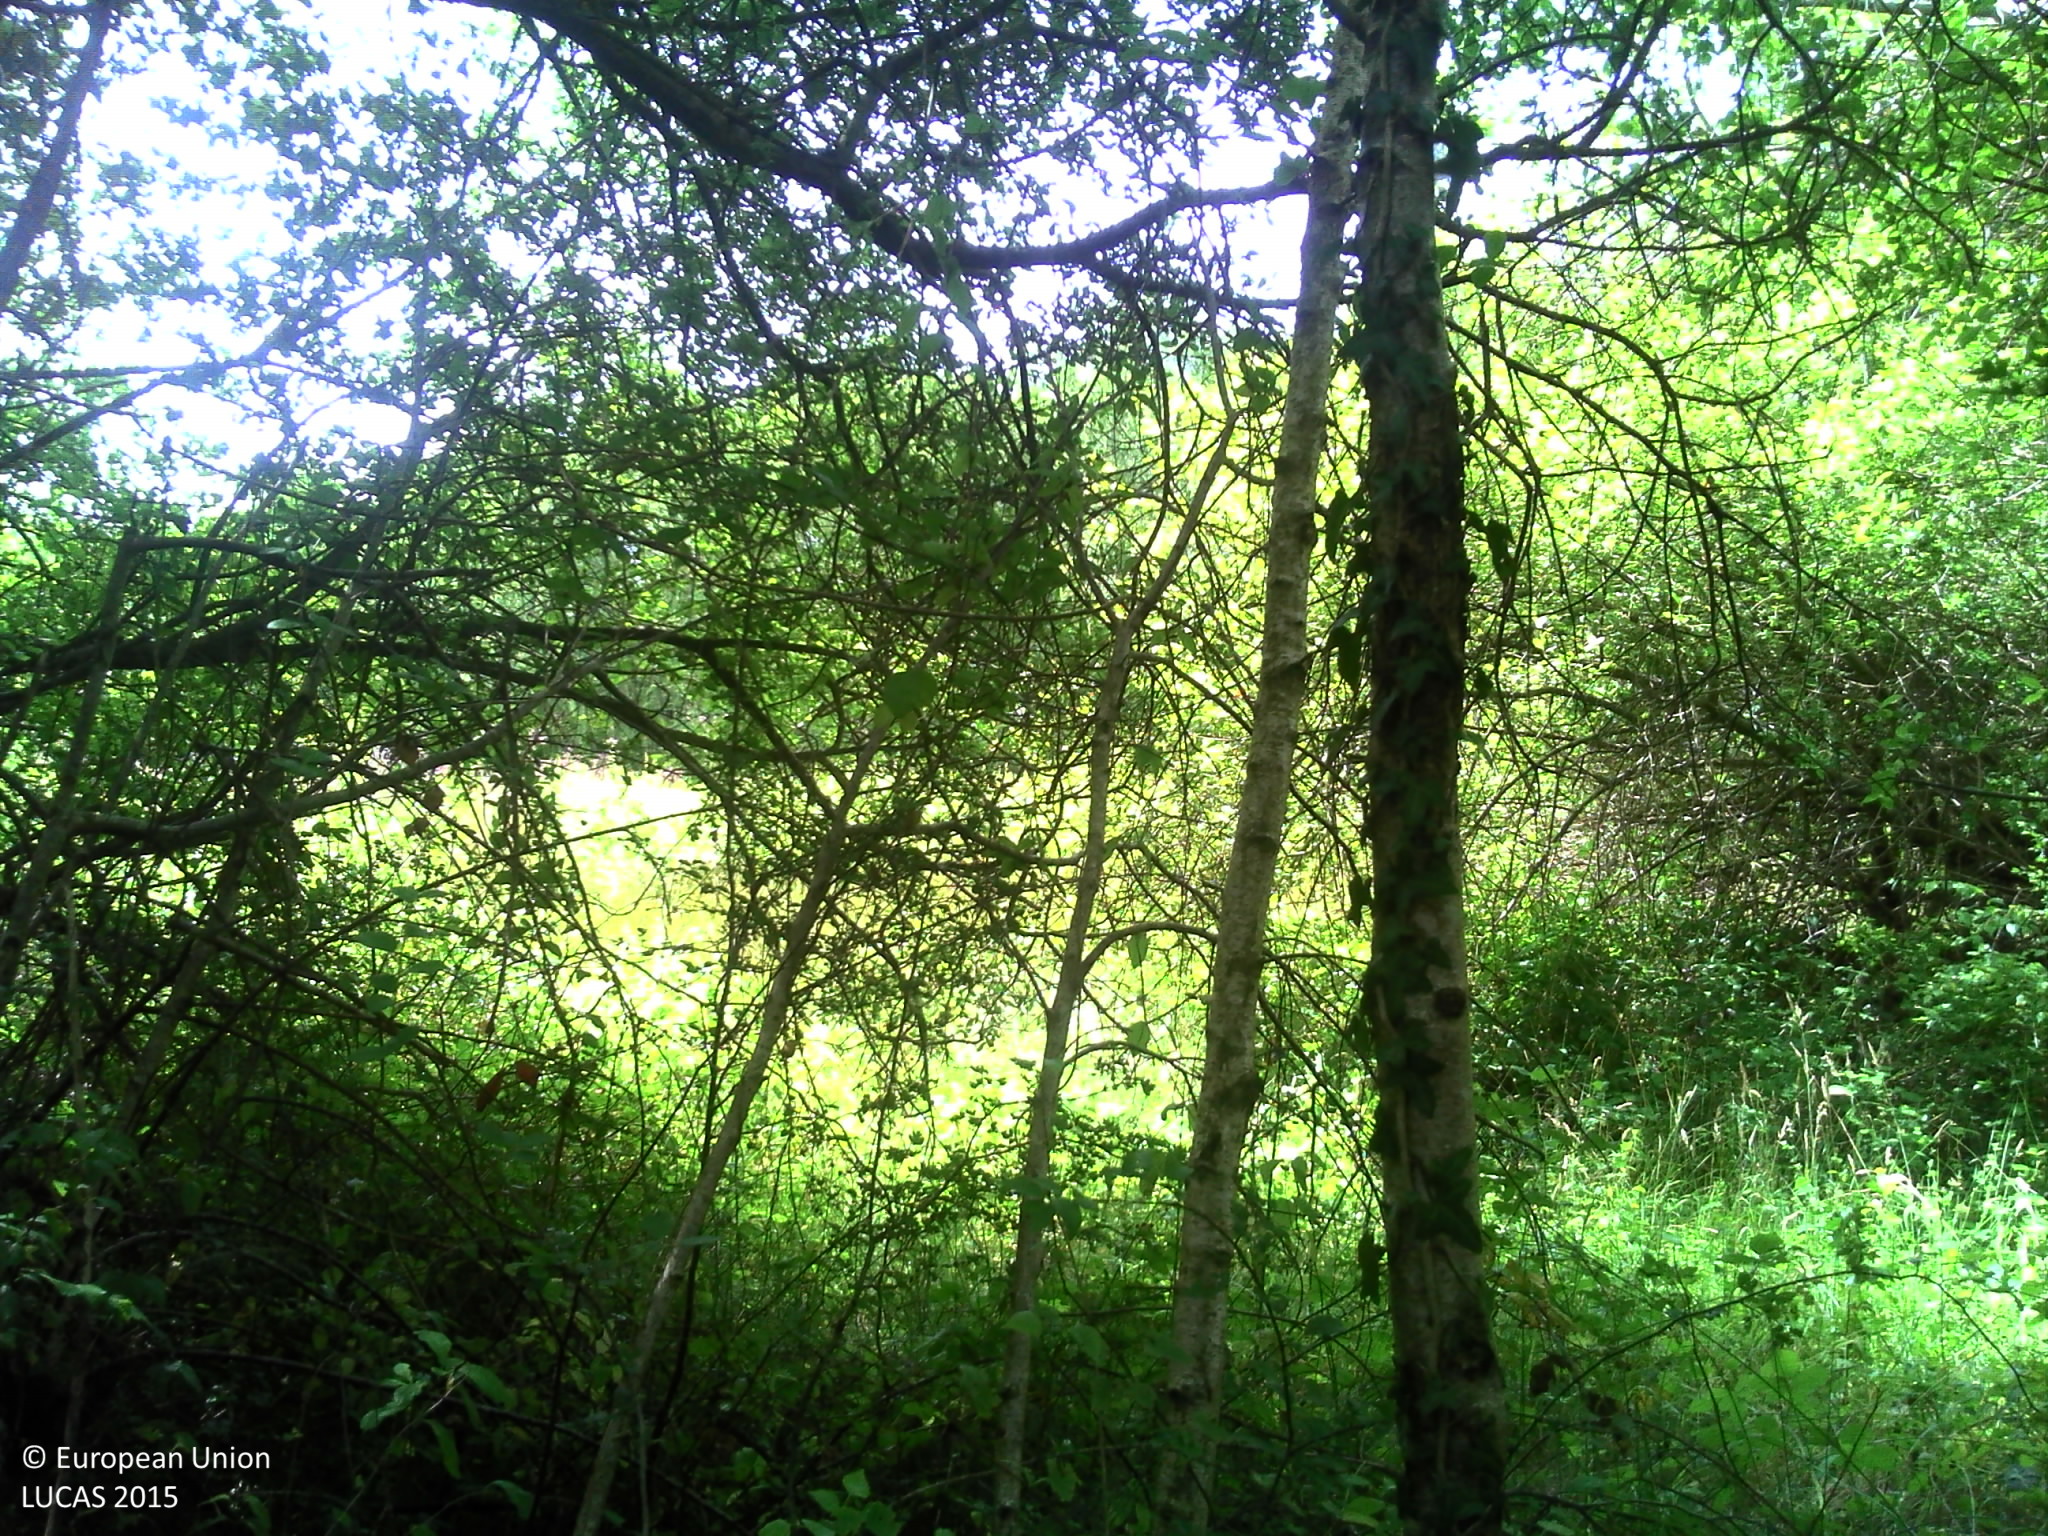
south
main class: Woodland
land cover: Broadleaved woodland
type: mesophytic deciduous forest
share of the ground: > 75 %
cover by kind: broadleaved forest trees 95 %, herbaceous plants 5 %
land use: Forestry
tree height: > 5 m
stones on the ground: < 10 %
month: June
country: FR
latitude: 47.7516
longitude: 2.7762
